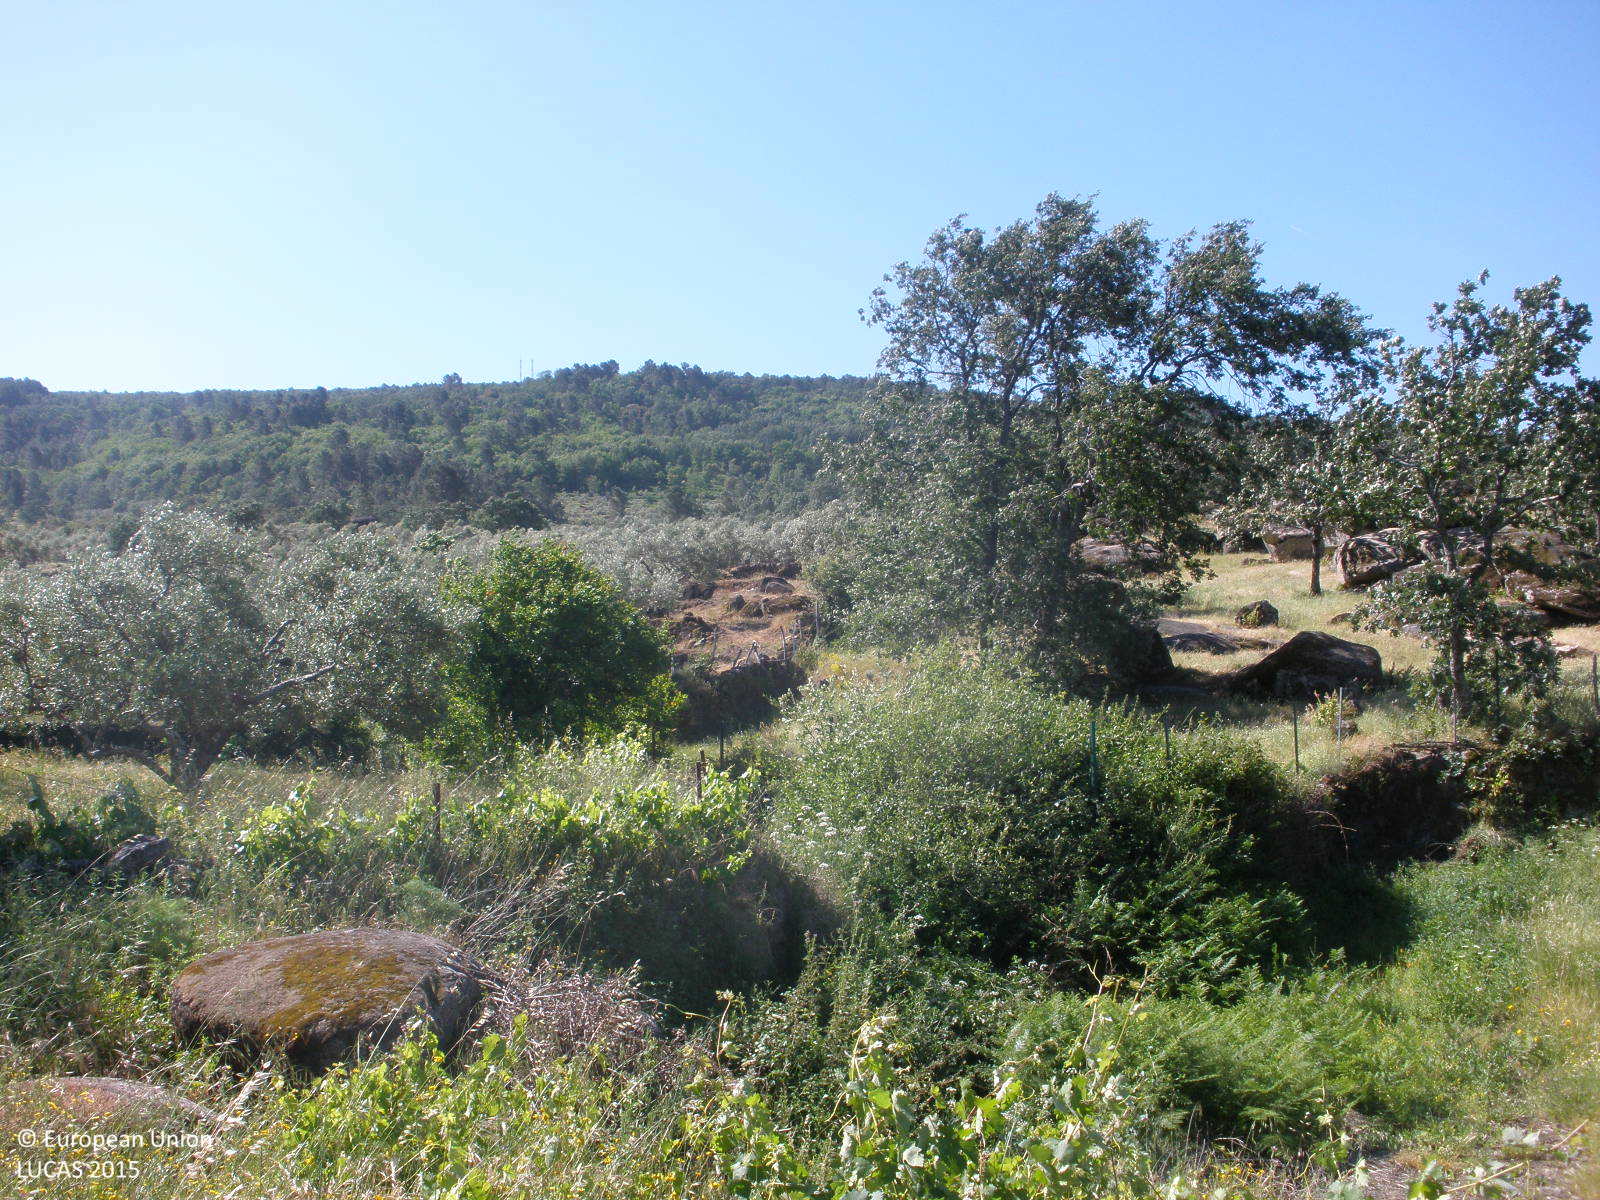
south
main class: Cropland
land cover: Olive groves
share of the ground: 50 - 75 %
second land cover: Spontaneously vegetated surfaces
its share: > 75 %
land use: Agriculture (excluding fallow land and kitchen gardens)
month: May
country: ES
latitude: 40.2062
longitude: -6.8080
